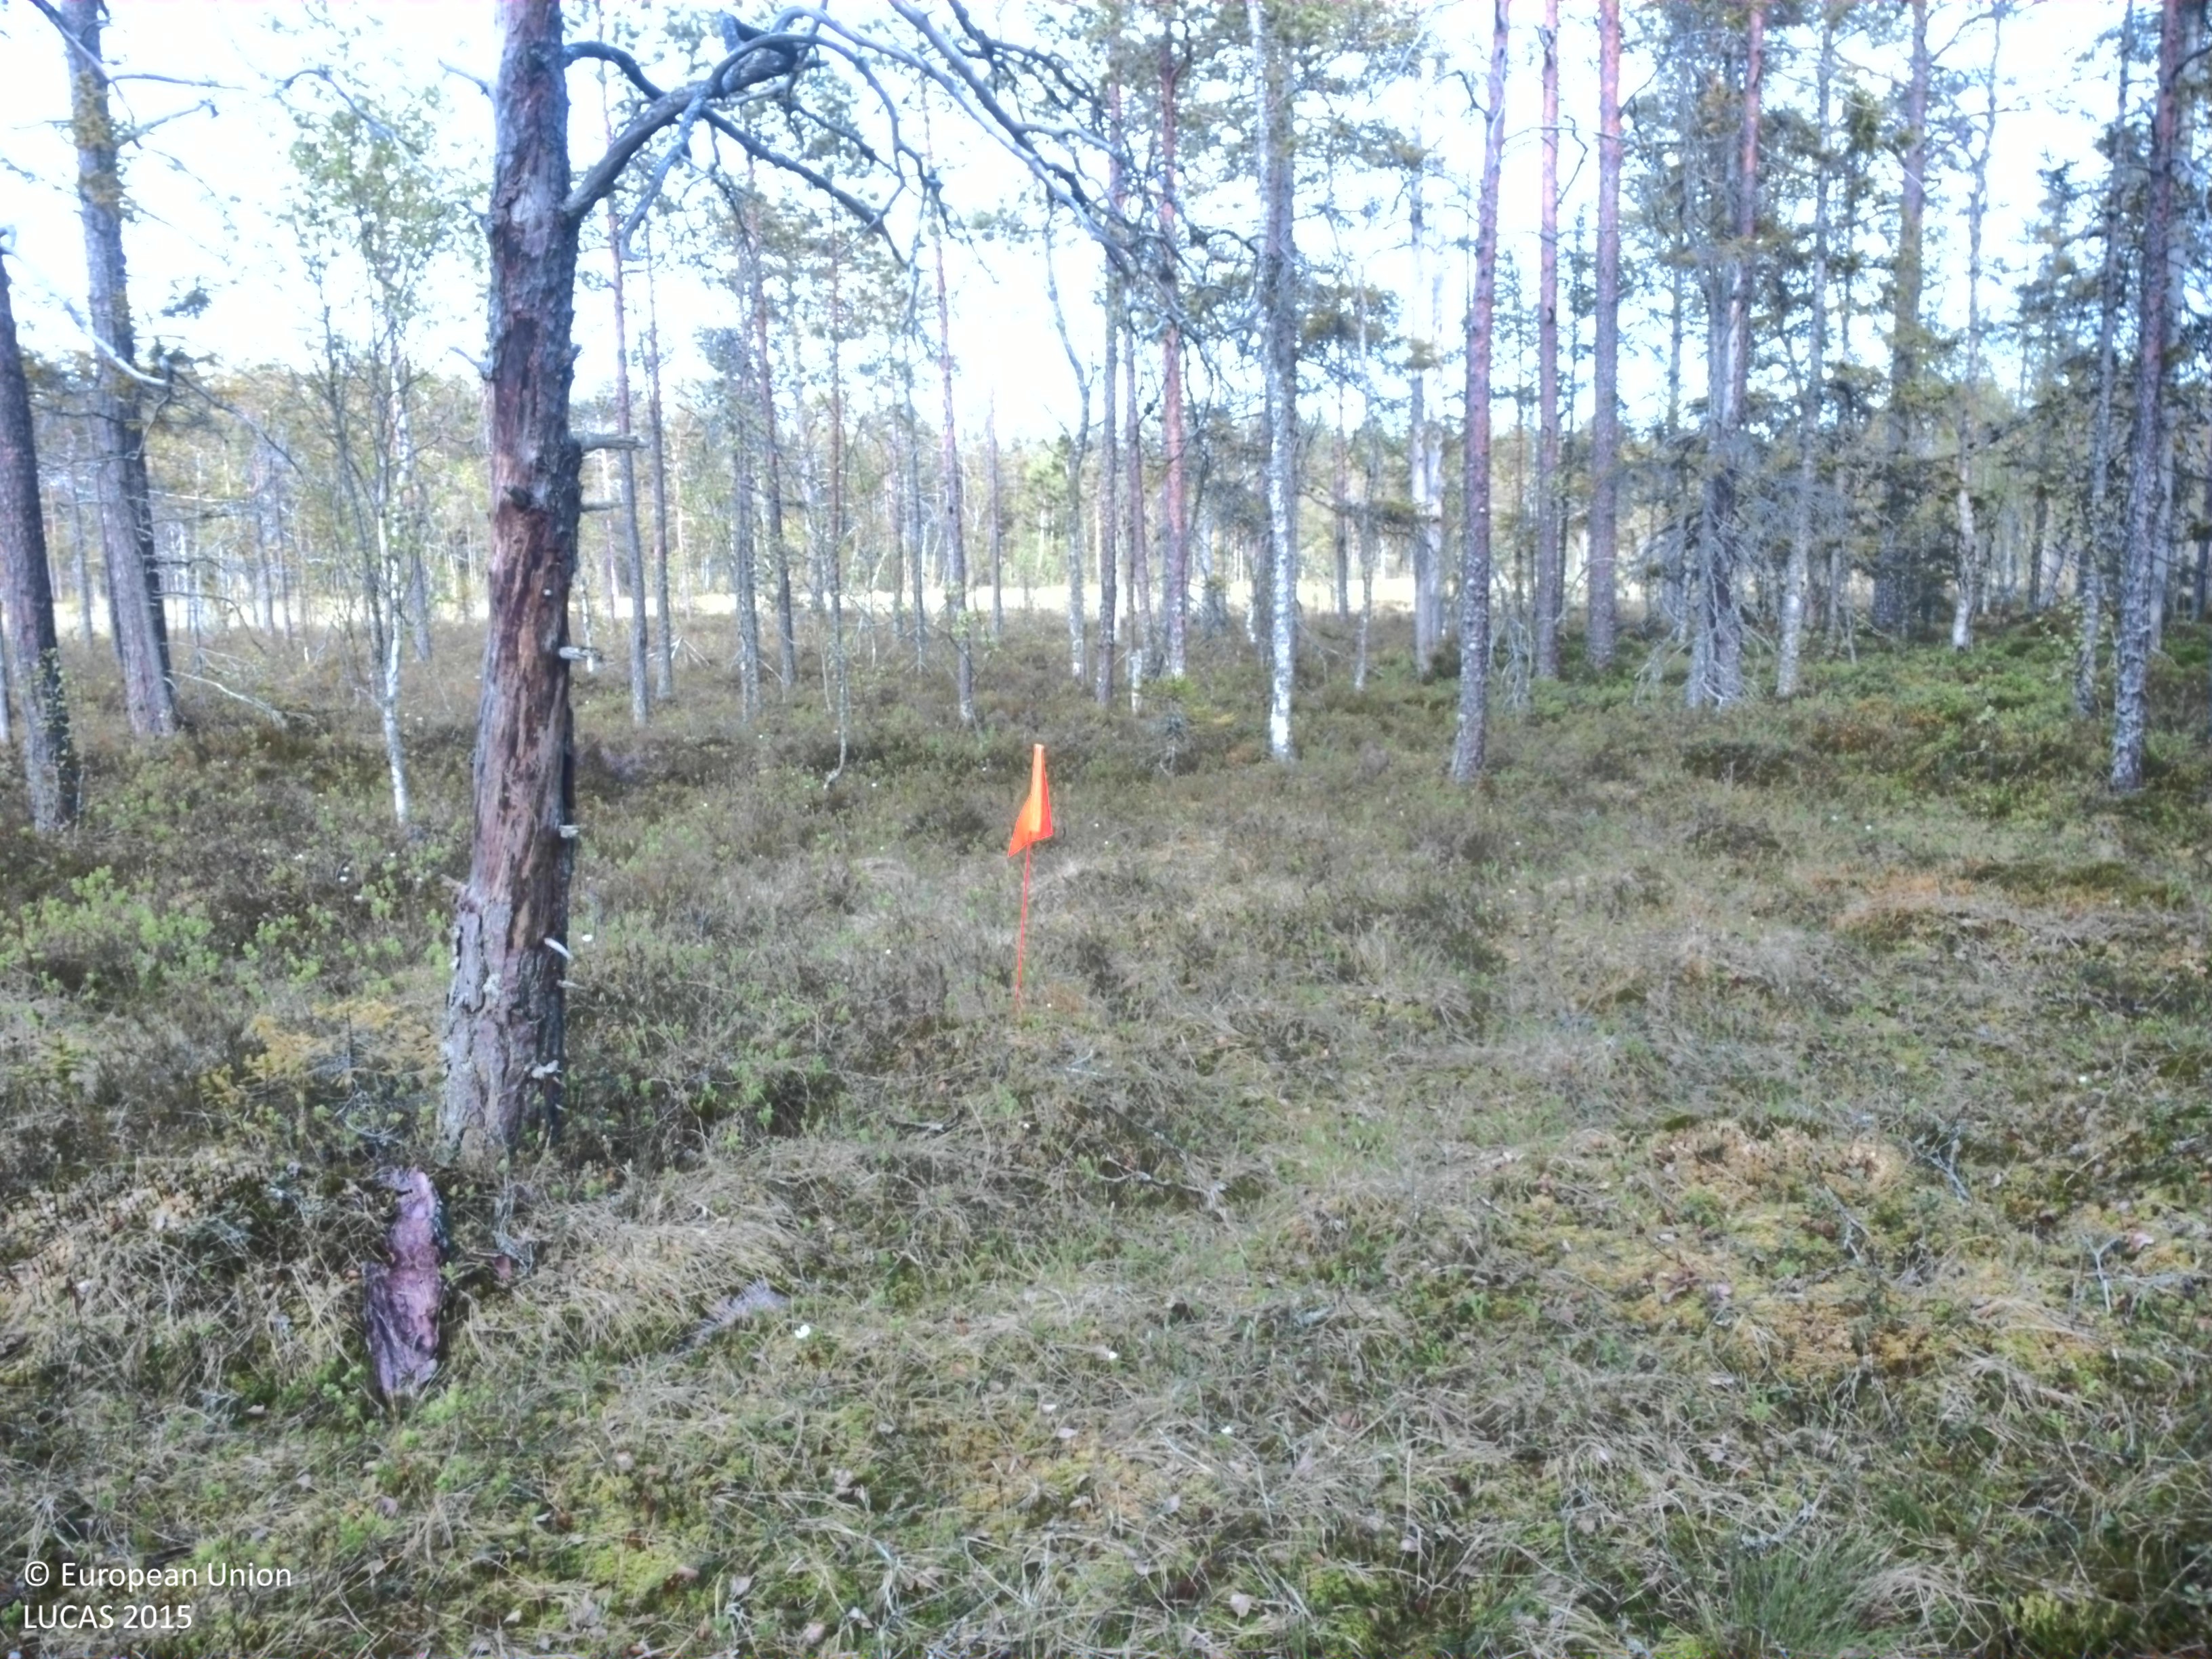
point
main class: Woodland
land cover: Pine dominated mixed woodland
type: boreal forest
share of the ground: 25 - 50 %
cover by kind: coniferous forest trees 30 %, shrubs 20 %, herbaceous plants 20 %, lichens and mosses 20 %, broadleaved forest trees 10 %
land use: Forestry
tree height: > 5 m
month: June
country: SE
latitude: 63.8557
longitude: 20.6635
